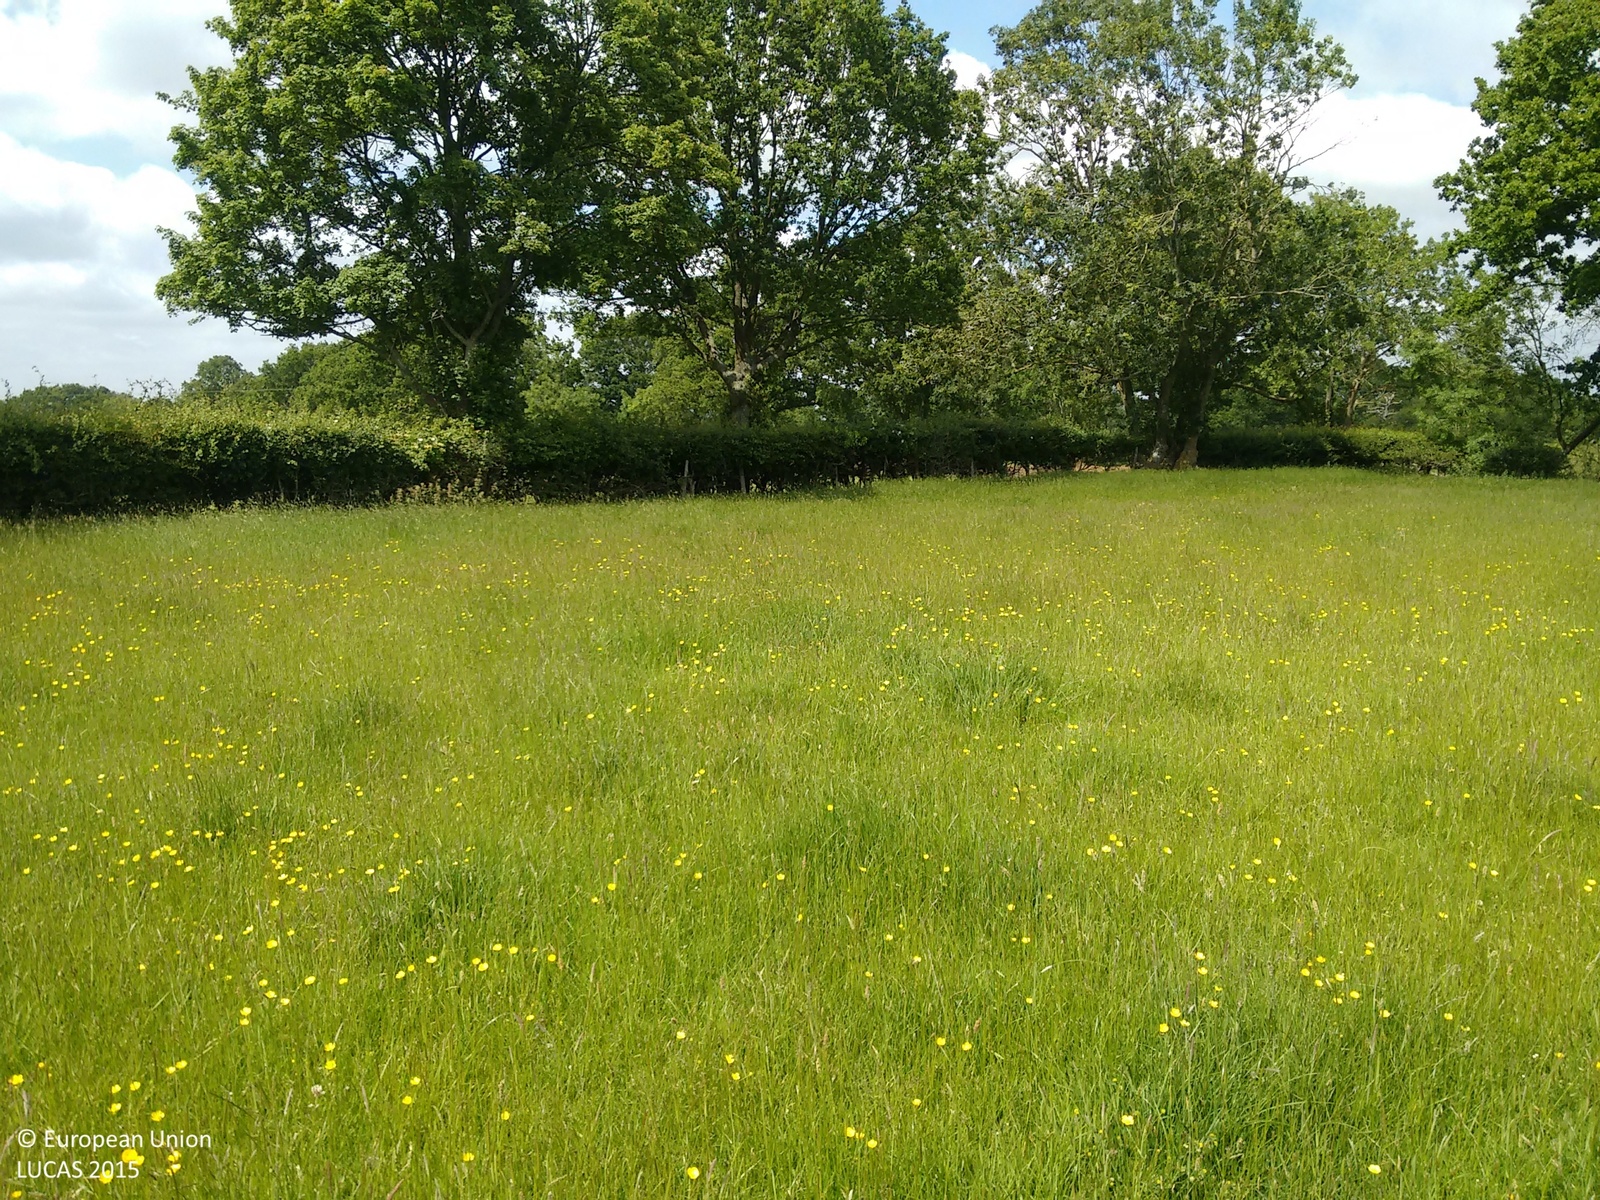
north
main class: Grassland
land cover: Grassland without tree/shrub cover
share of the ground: > 75 %
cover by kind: herbaceous plants 100 %
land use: Agriculture (excluding fallow land and kitchen gardens)
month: June
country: GB
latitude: 51.1180
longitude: 0.6158
